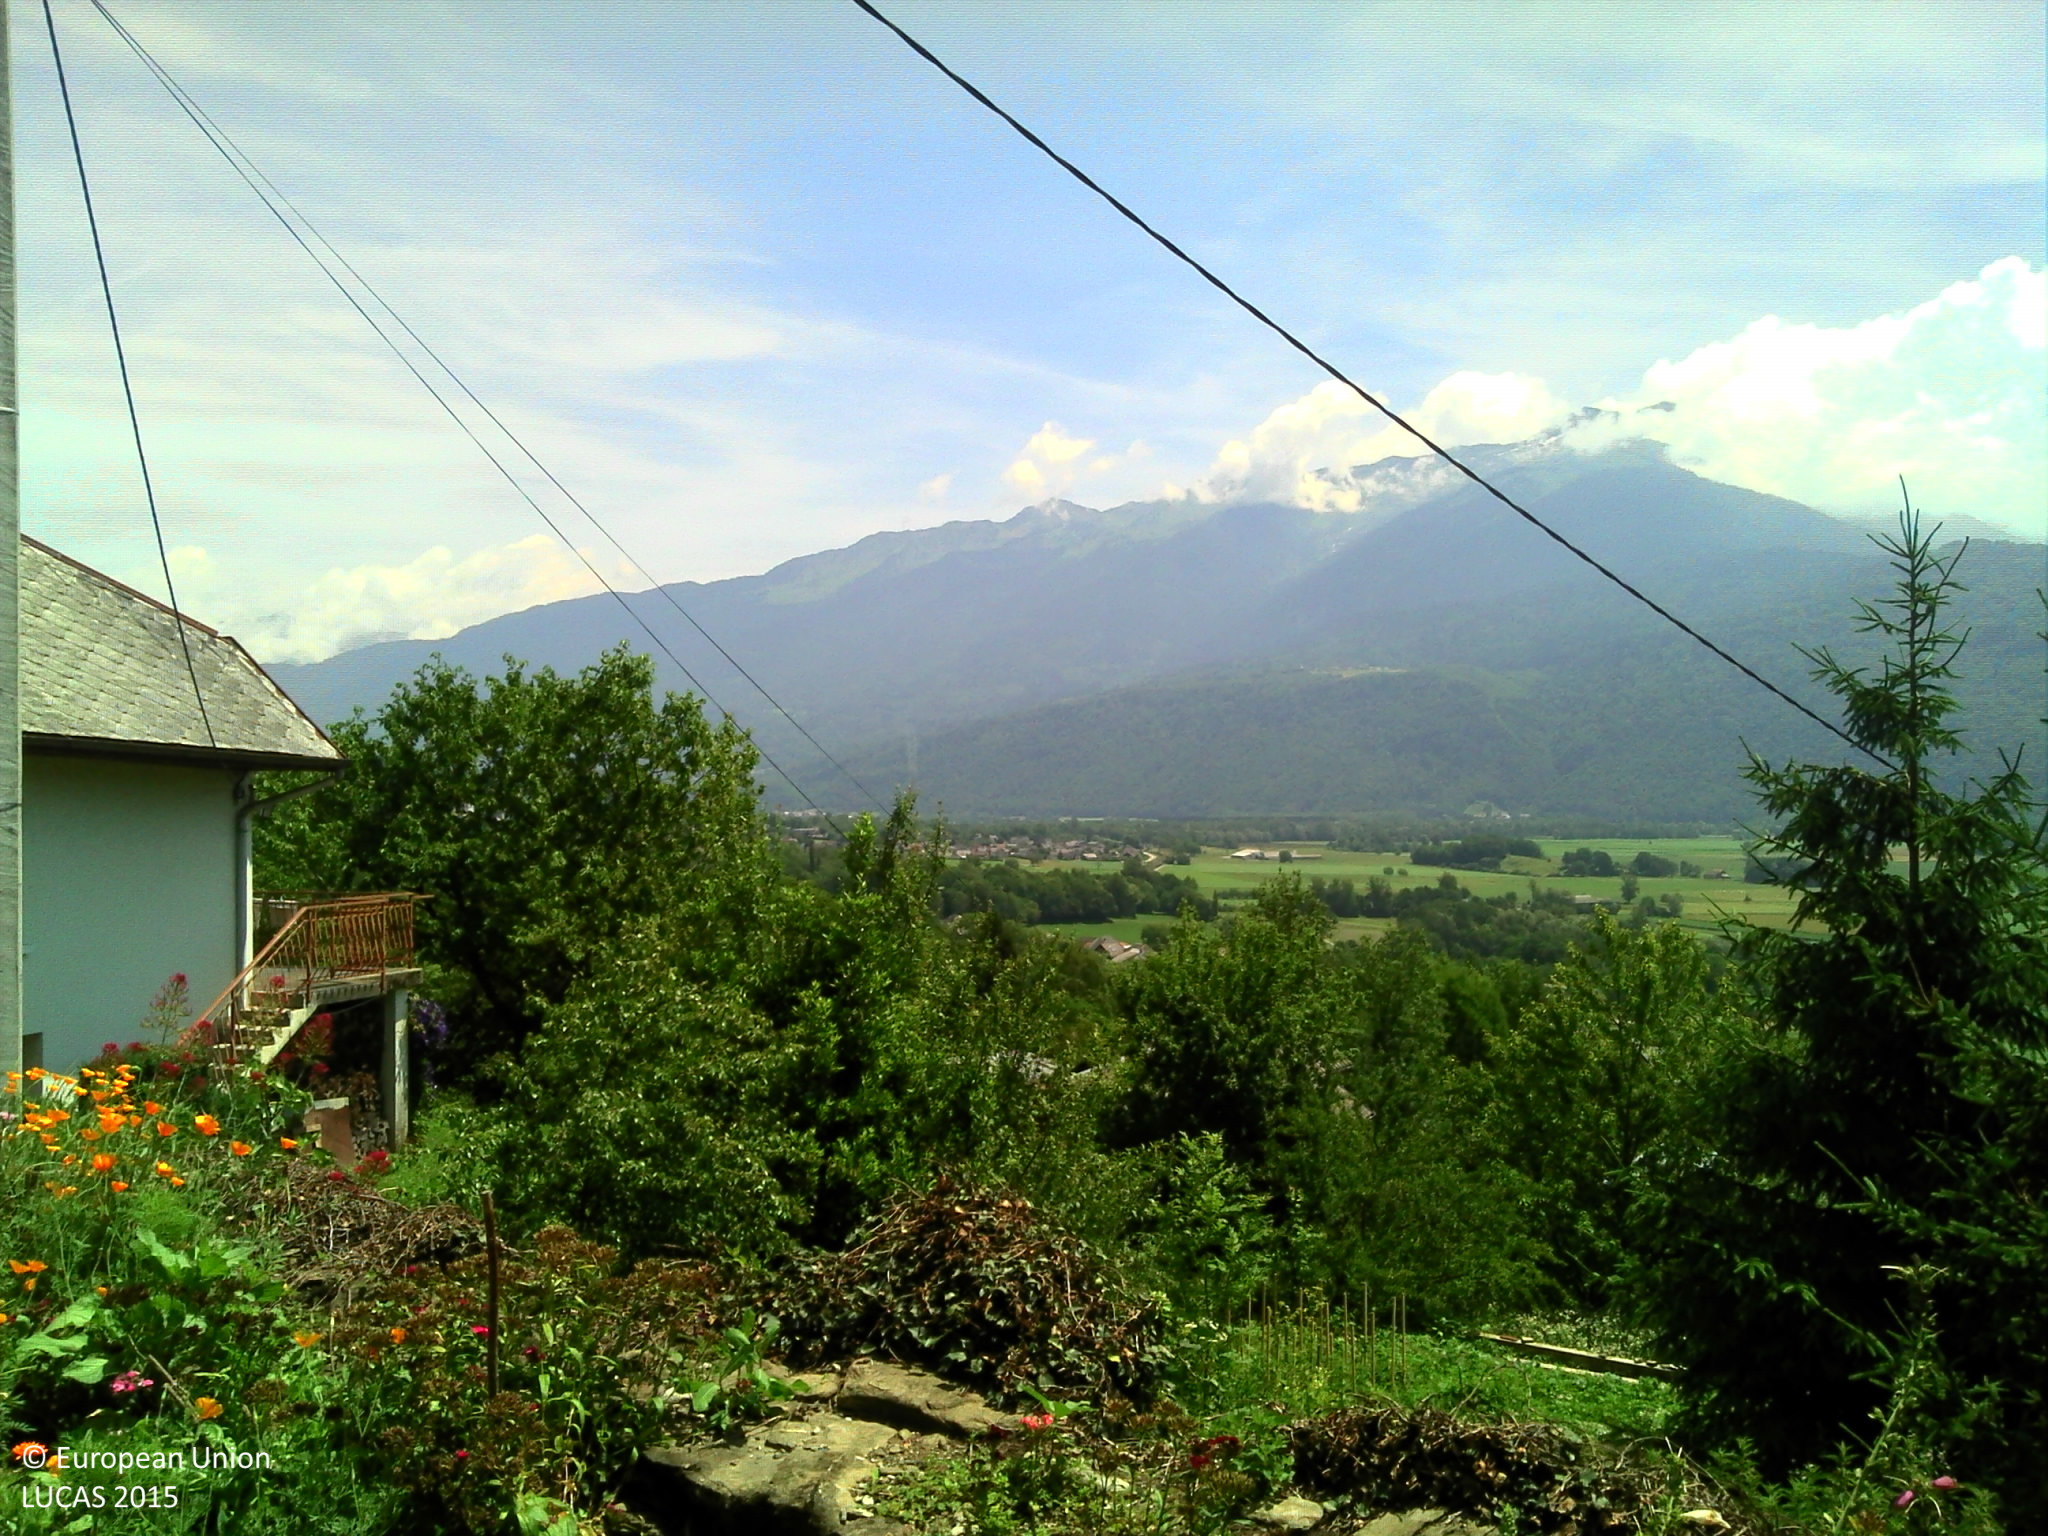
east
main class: Woodland
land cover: Broadleaved woodland
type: mountainous beech forest
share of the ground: > 75 %
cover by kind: broadleaved forest trees 100 %
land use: Forestry
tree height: > 5 m
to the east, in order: Broadleaved woodland; Rivers and streams; Broadleaved woodland
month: June
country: FR
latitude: 45.5992
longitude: 6.2225
